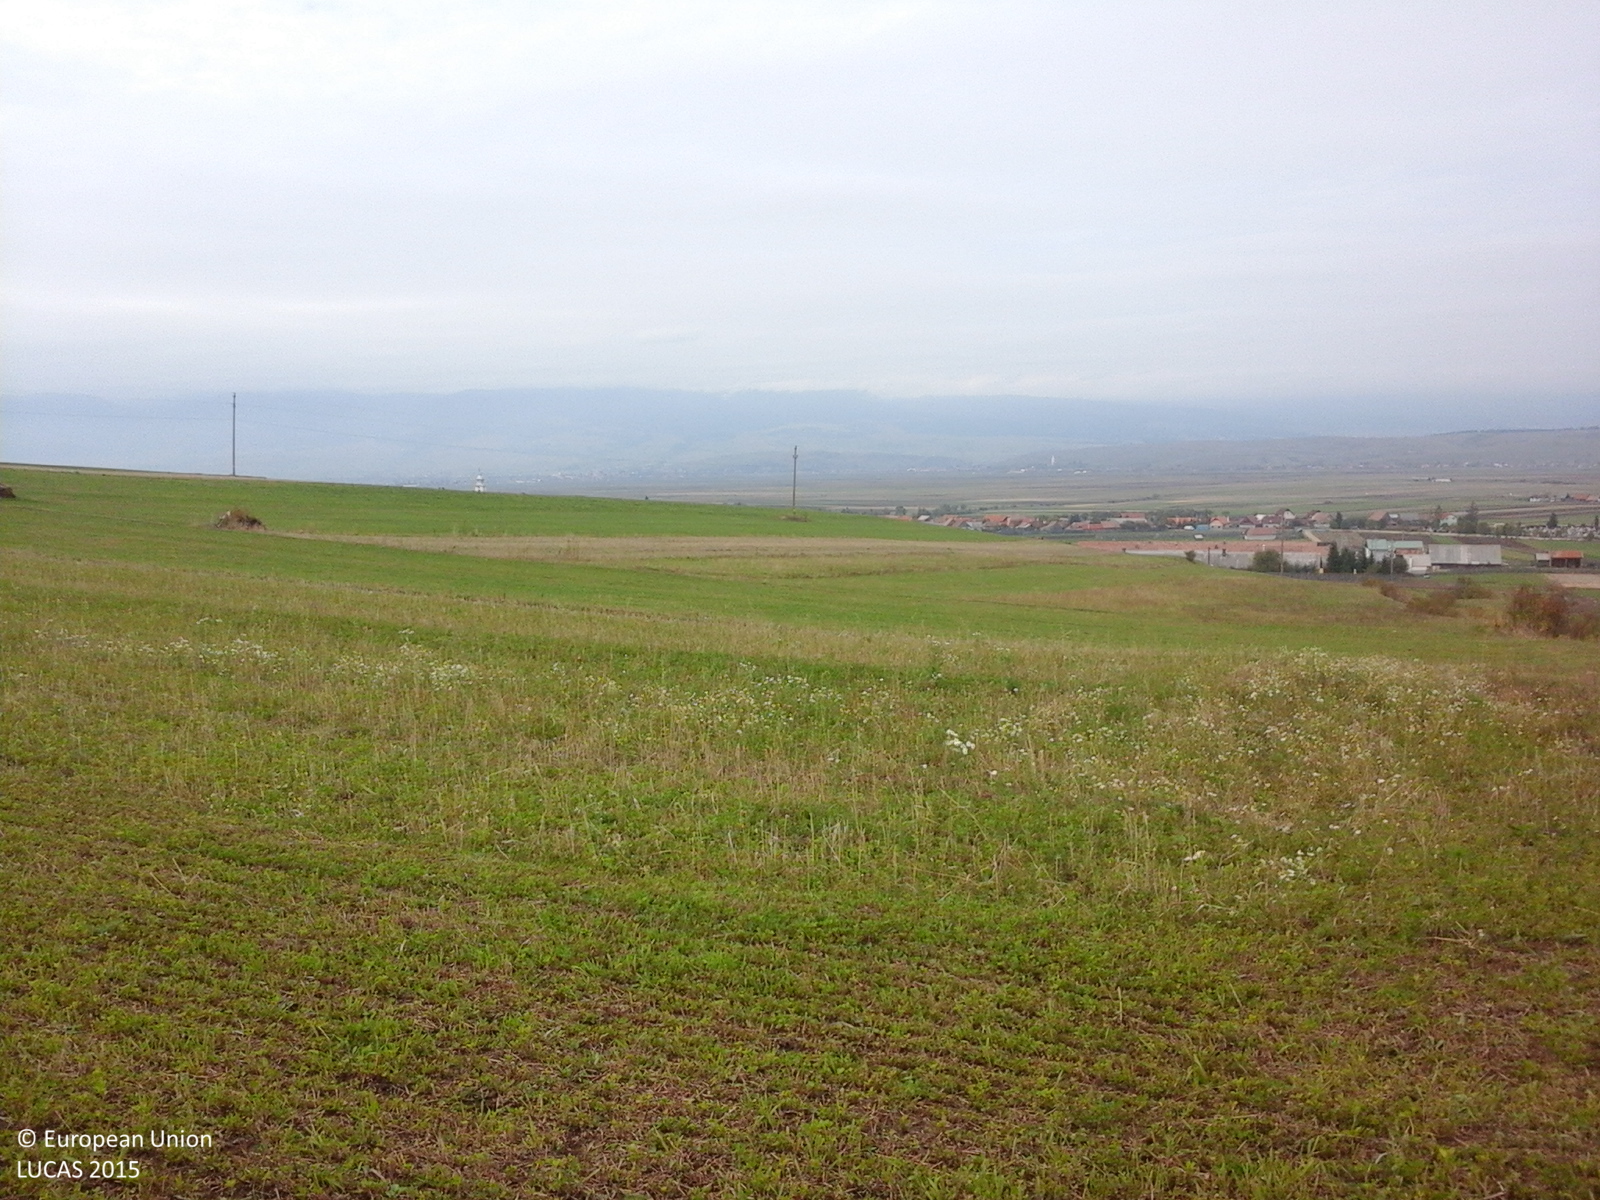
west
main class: Cropland
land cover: Lucerne
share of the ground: > 75 %
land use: Agriculture (excluding fallow land and kitchen gardens)
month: October
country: RO
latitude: 46.4431
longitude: 25.8542
